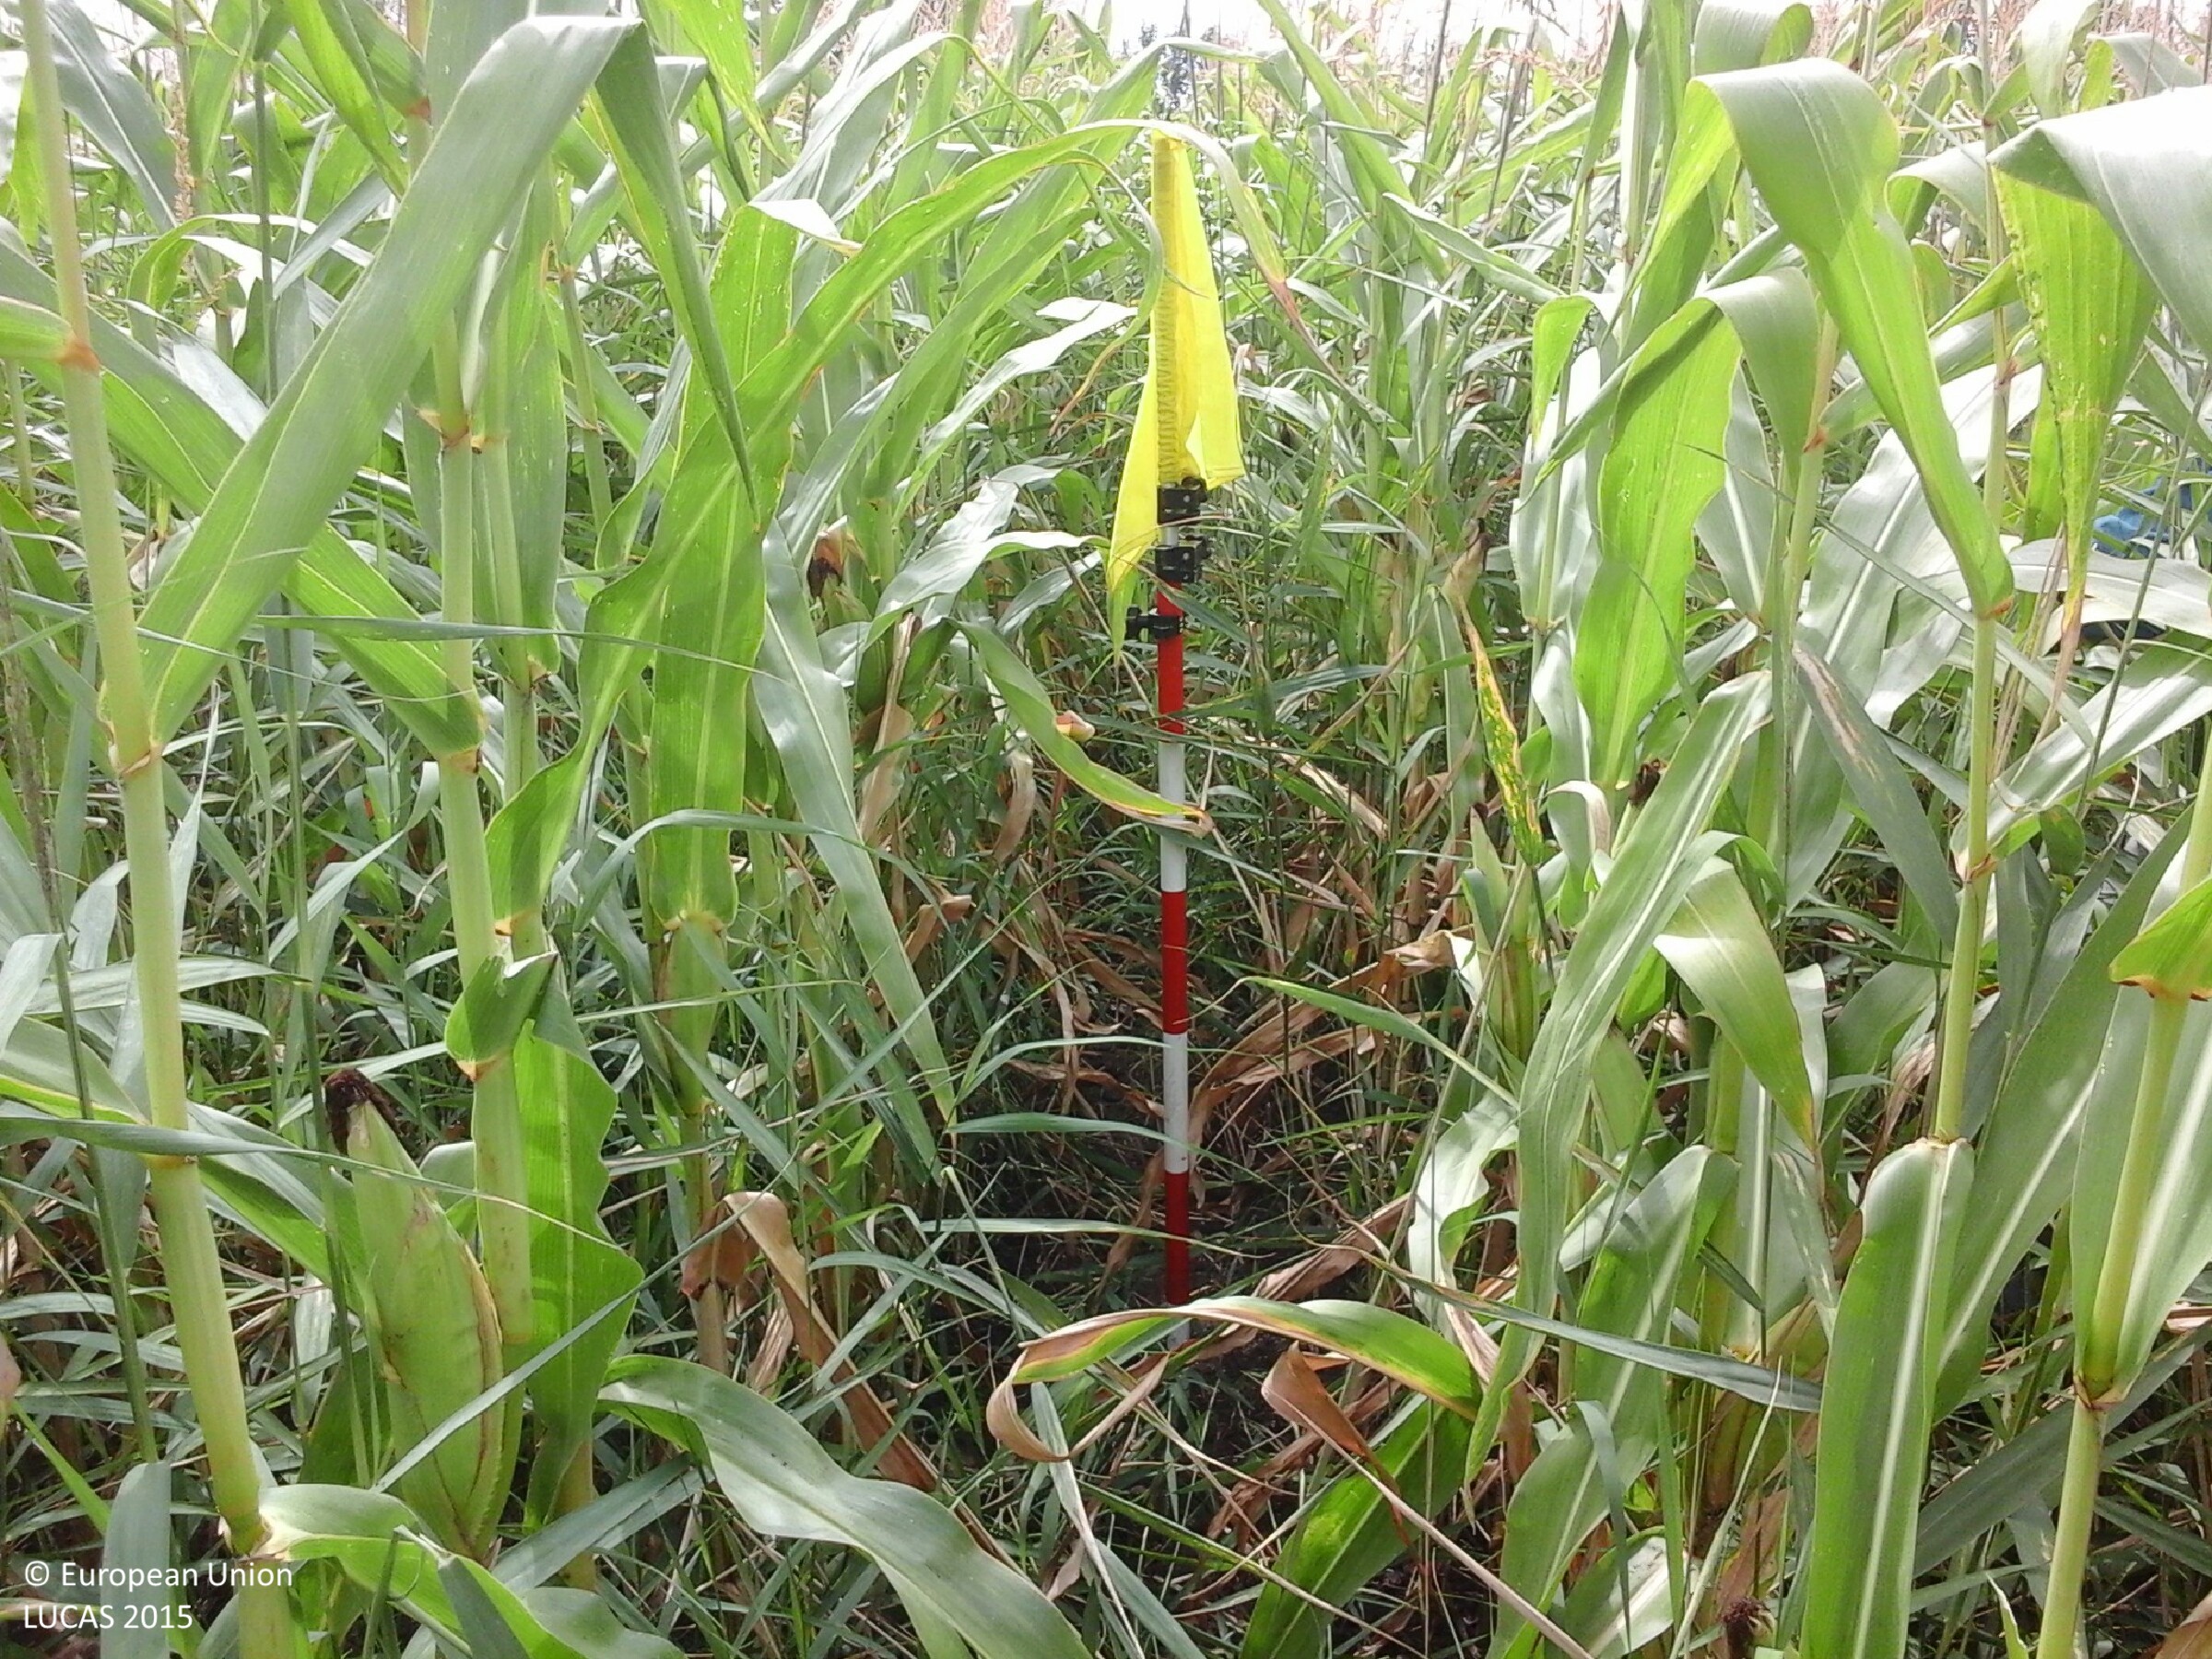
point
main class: Cropland
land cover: Maize
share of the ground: > 75 %
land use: Agriculture (excluding fallow land and kitchen gardens)
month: July
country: HU
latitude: 47.4055
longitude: 20.7538
